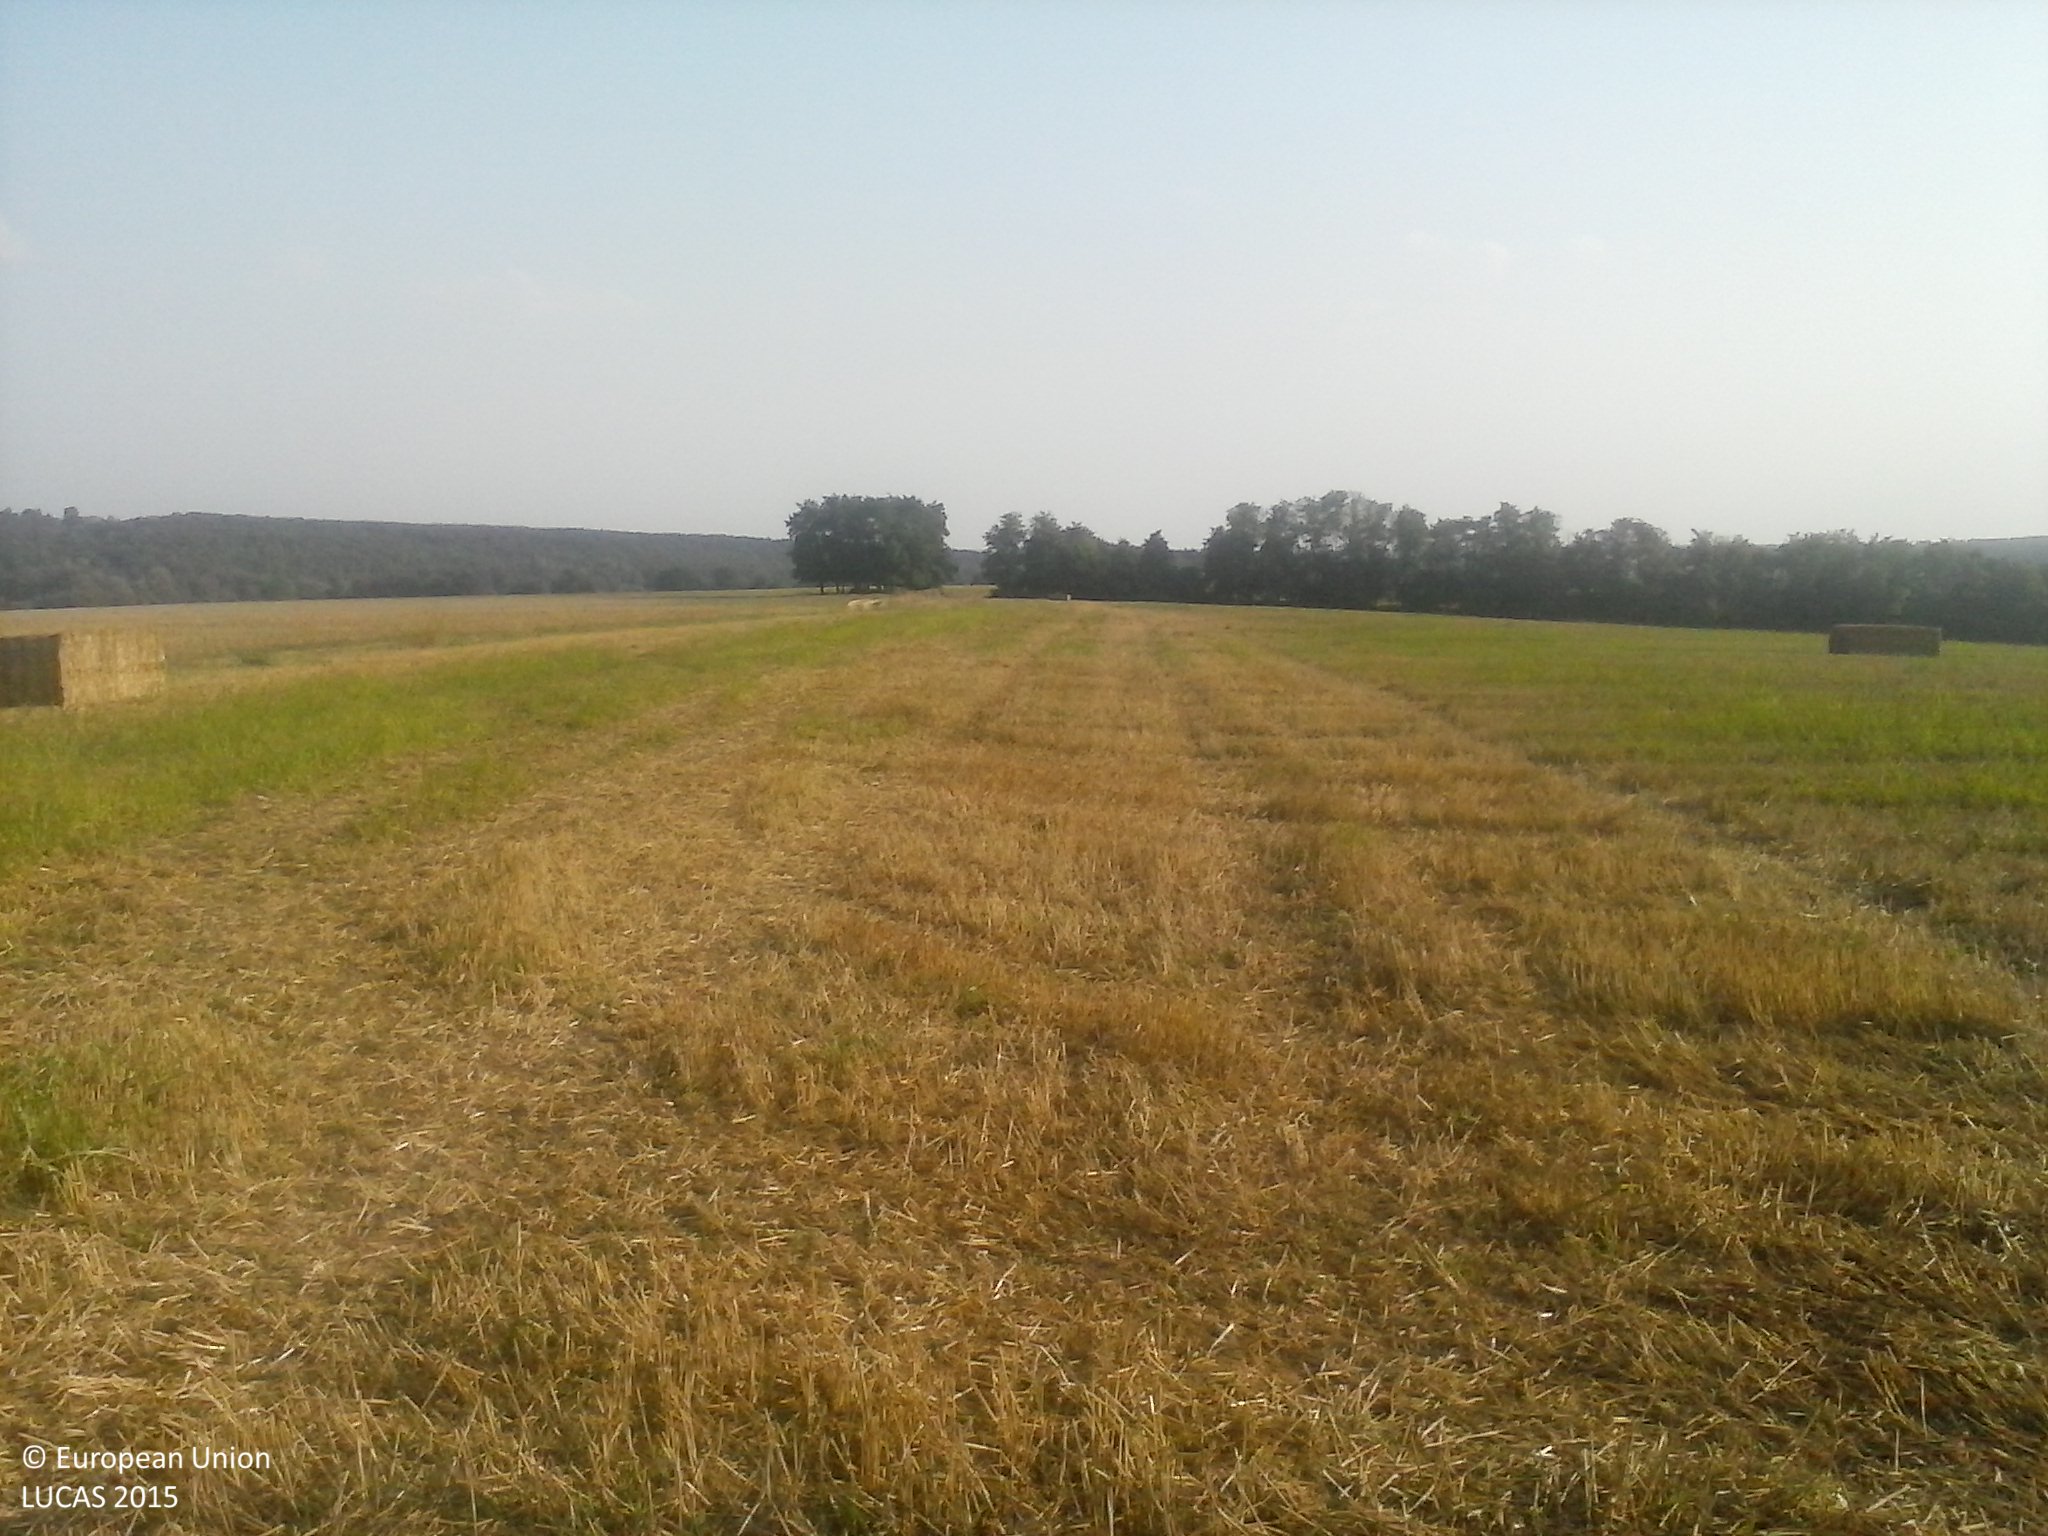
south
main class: Cropland
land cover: Common wheat
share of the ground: > 75 %
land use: Agriculture (excluding fallow land and kitchen gardens)
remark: Harvested field
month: August
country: HU
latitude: 46.1414
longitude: 17.7593
